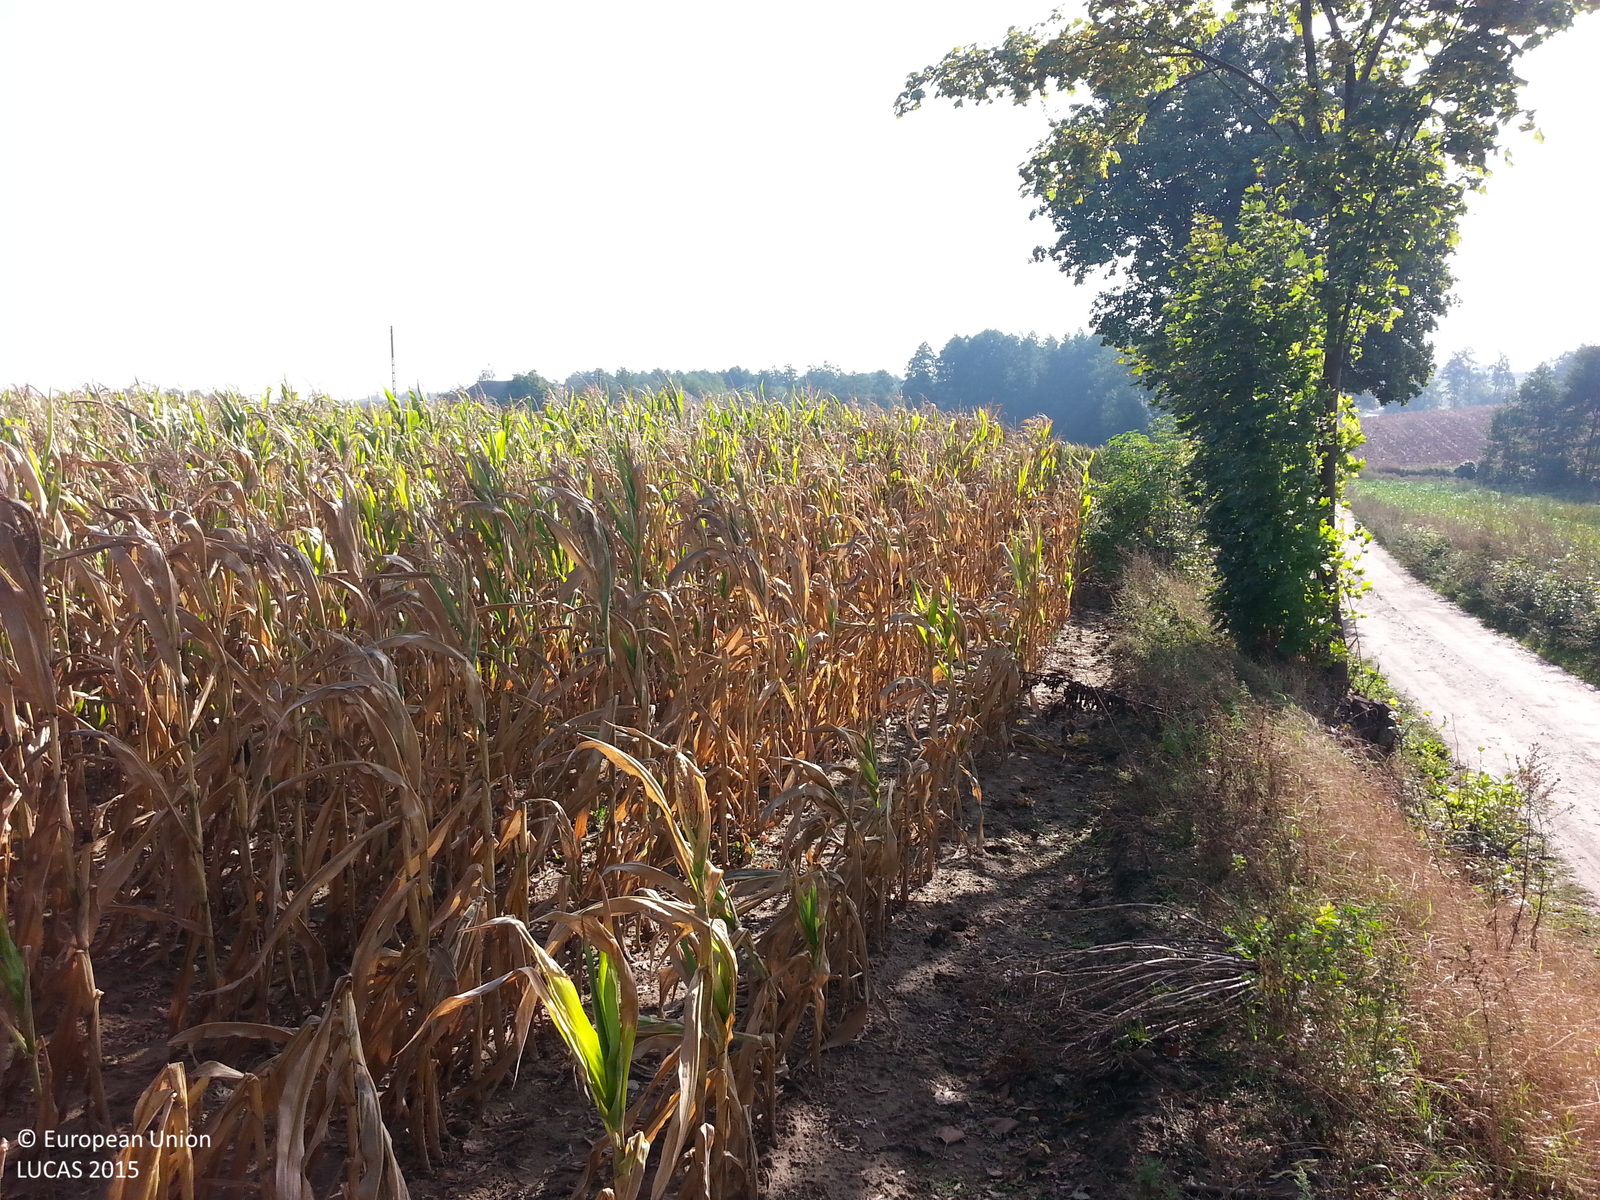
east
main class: Cropland
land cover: Maize
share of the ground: > 75 %
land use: Agriculture (excluding fallow land and kitchen gardens)
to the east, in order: Maize; Grass margins; Maize; Grass margins; Triticale
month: September
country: PL
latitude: 53.1247
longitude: 19.1847
